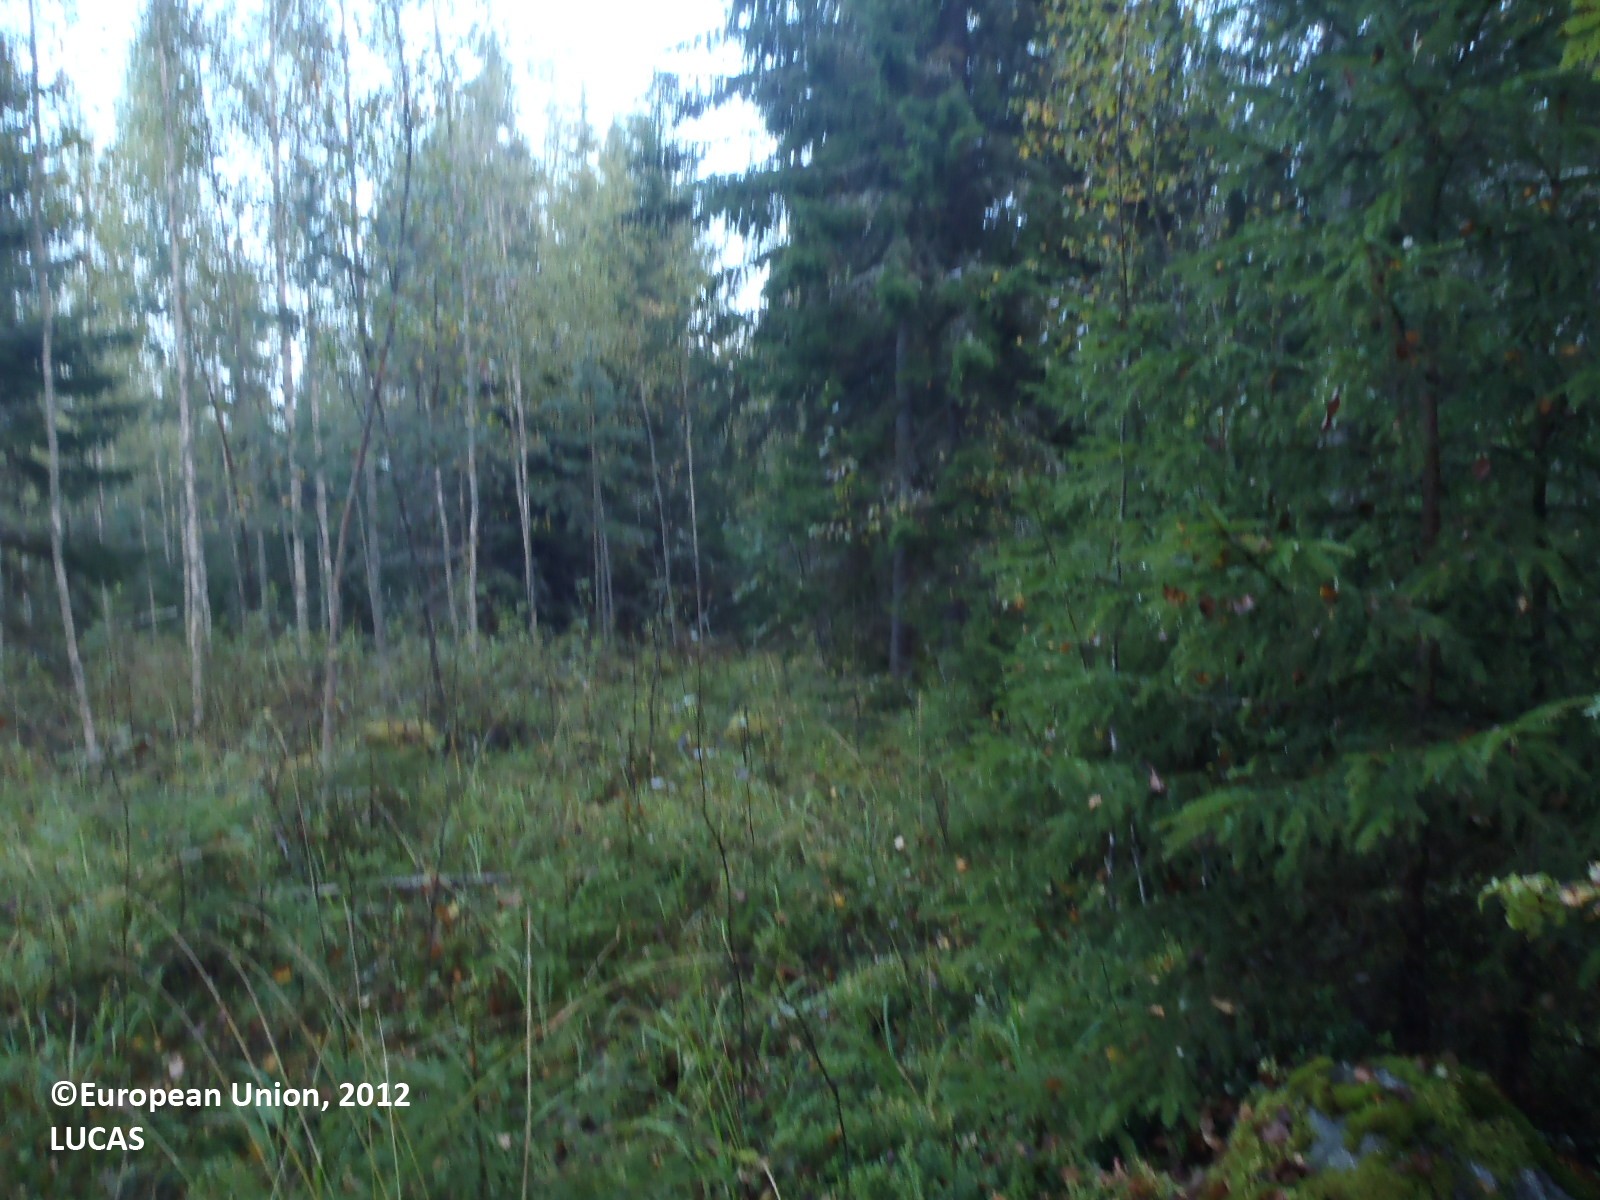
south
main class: Woodland
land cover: Broadleaved woodland
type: boreal forest
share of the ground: 50 - 75 %
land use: Forestry
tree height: > 5 m
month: September
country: FI
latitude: 61.5181
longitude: 22.7555
